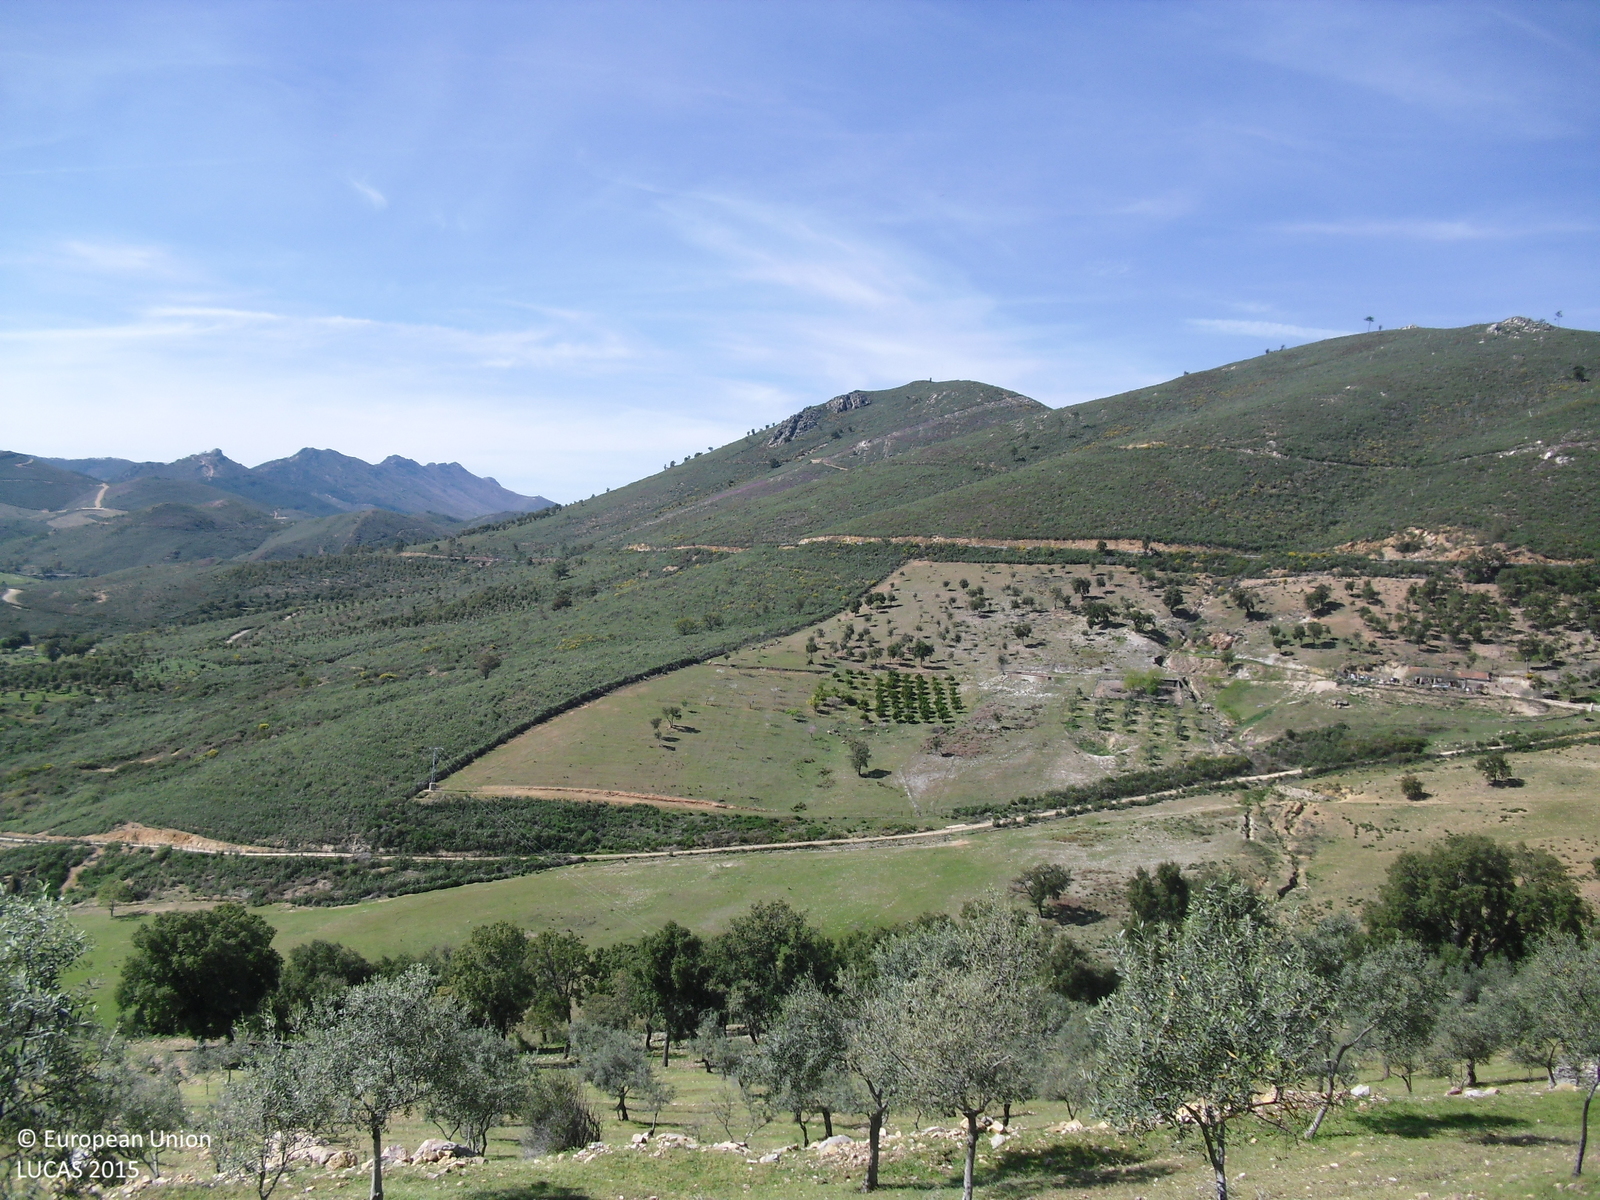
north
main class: Cropland
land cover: Olive groves
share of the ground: 10 - 25 %
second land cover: Spontaneously vegetated surfaces
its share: > 75 %
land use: Agriculture (excluding fallow land and kitchen gardens)
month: April
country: ES
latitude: 39.3665
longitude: -5.3330
